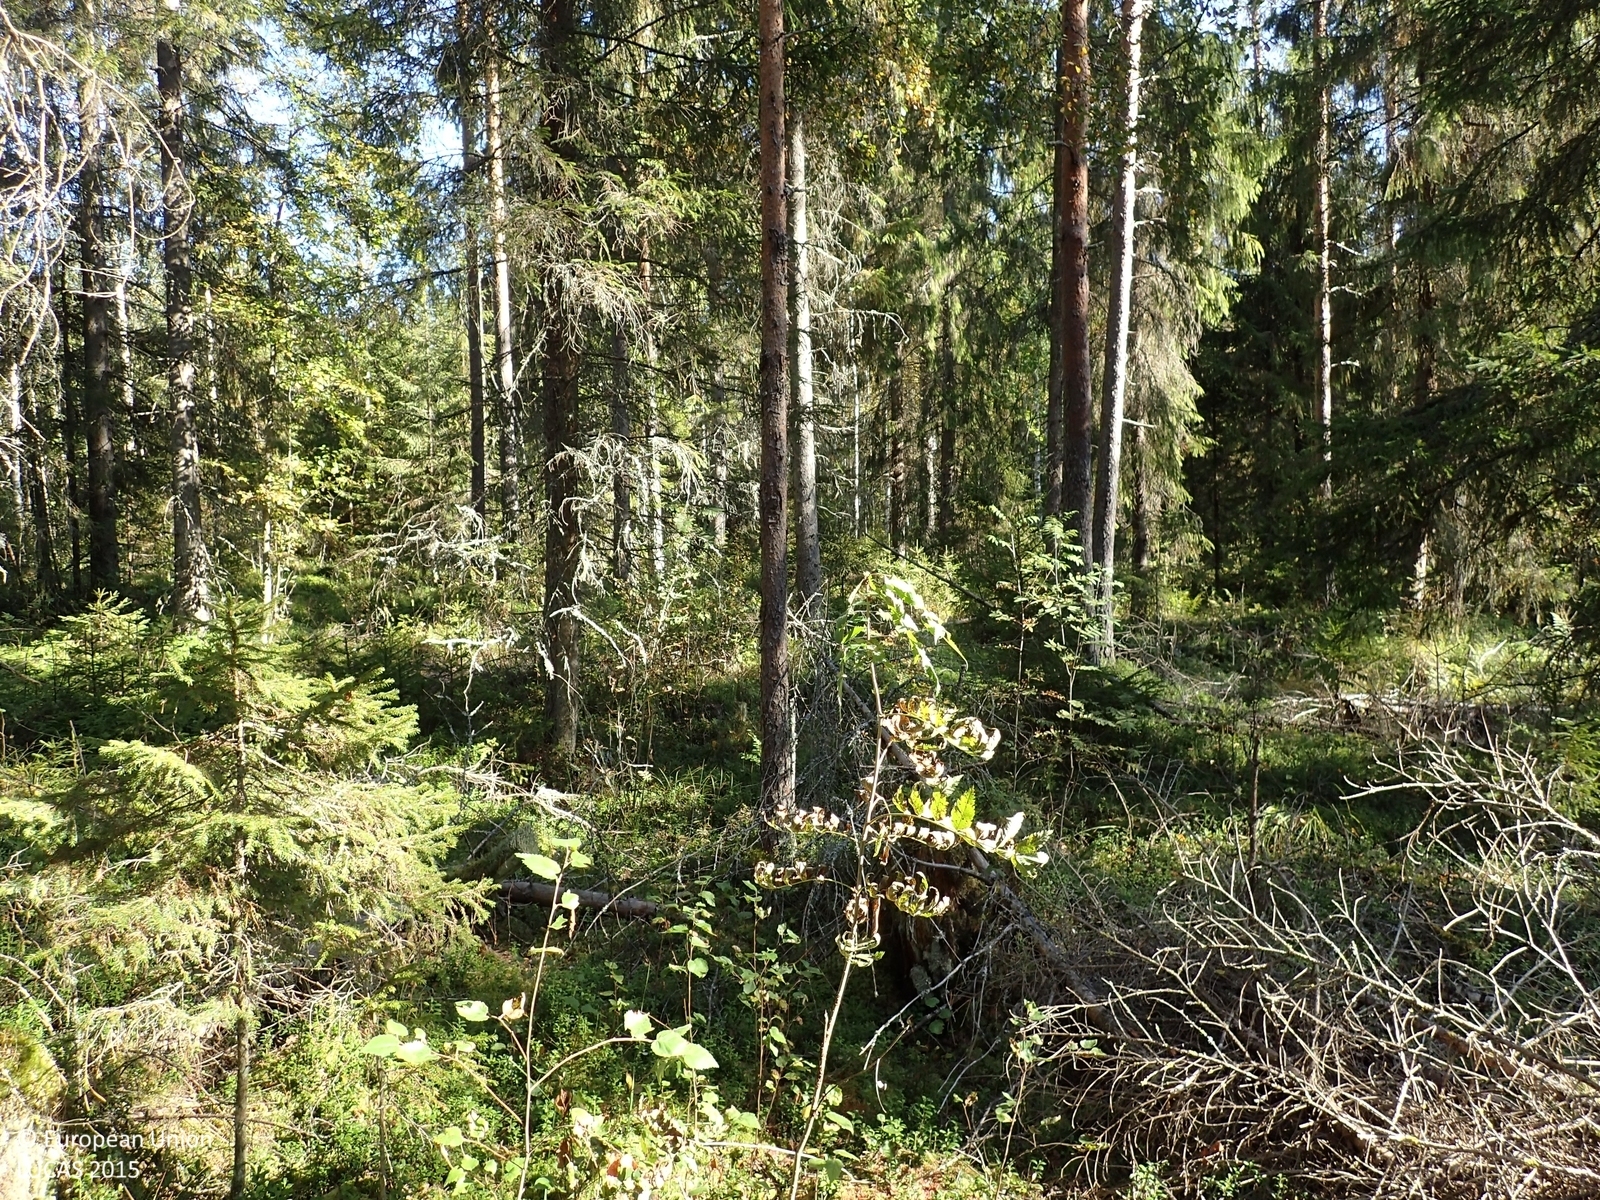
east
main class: Woodland
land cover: Spruce dominated coniferous woodland
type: boreal forest
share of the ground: > 75 %
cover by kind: coniferous forest trees 65 %, shrubs 20 %, broadleaved forest trees 10 %, herbaceous plants 5 %
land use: Forestry
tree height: > 5 m
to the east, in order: Spruce dominated coniferous woodland; Spruce dominated mixed woodland; Broadleaved woodland; Spruce dominated mixed woodland; Ditches and canals; Spruce dominated mixed woodland; Ditches and canals; Spruce dominated mixed woodland; Ditches and canals; Pine dominated mixed woodland
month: September
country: FI
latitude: 62.9153
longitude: 25.4422
